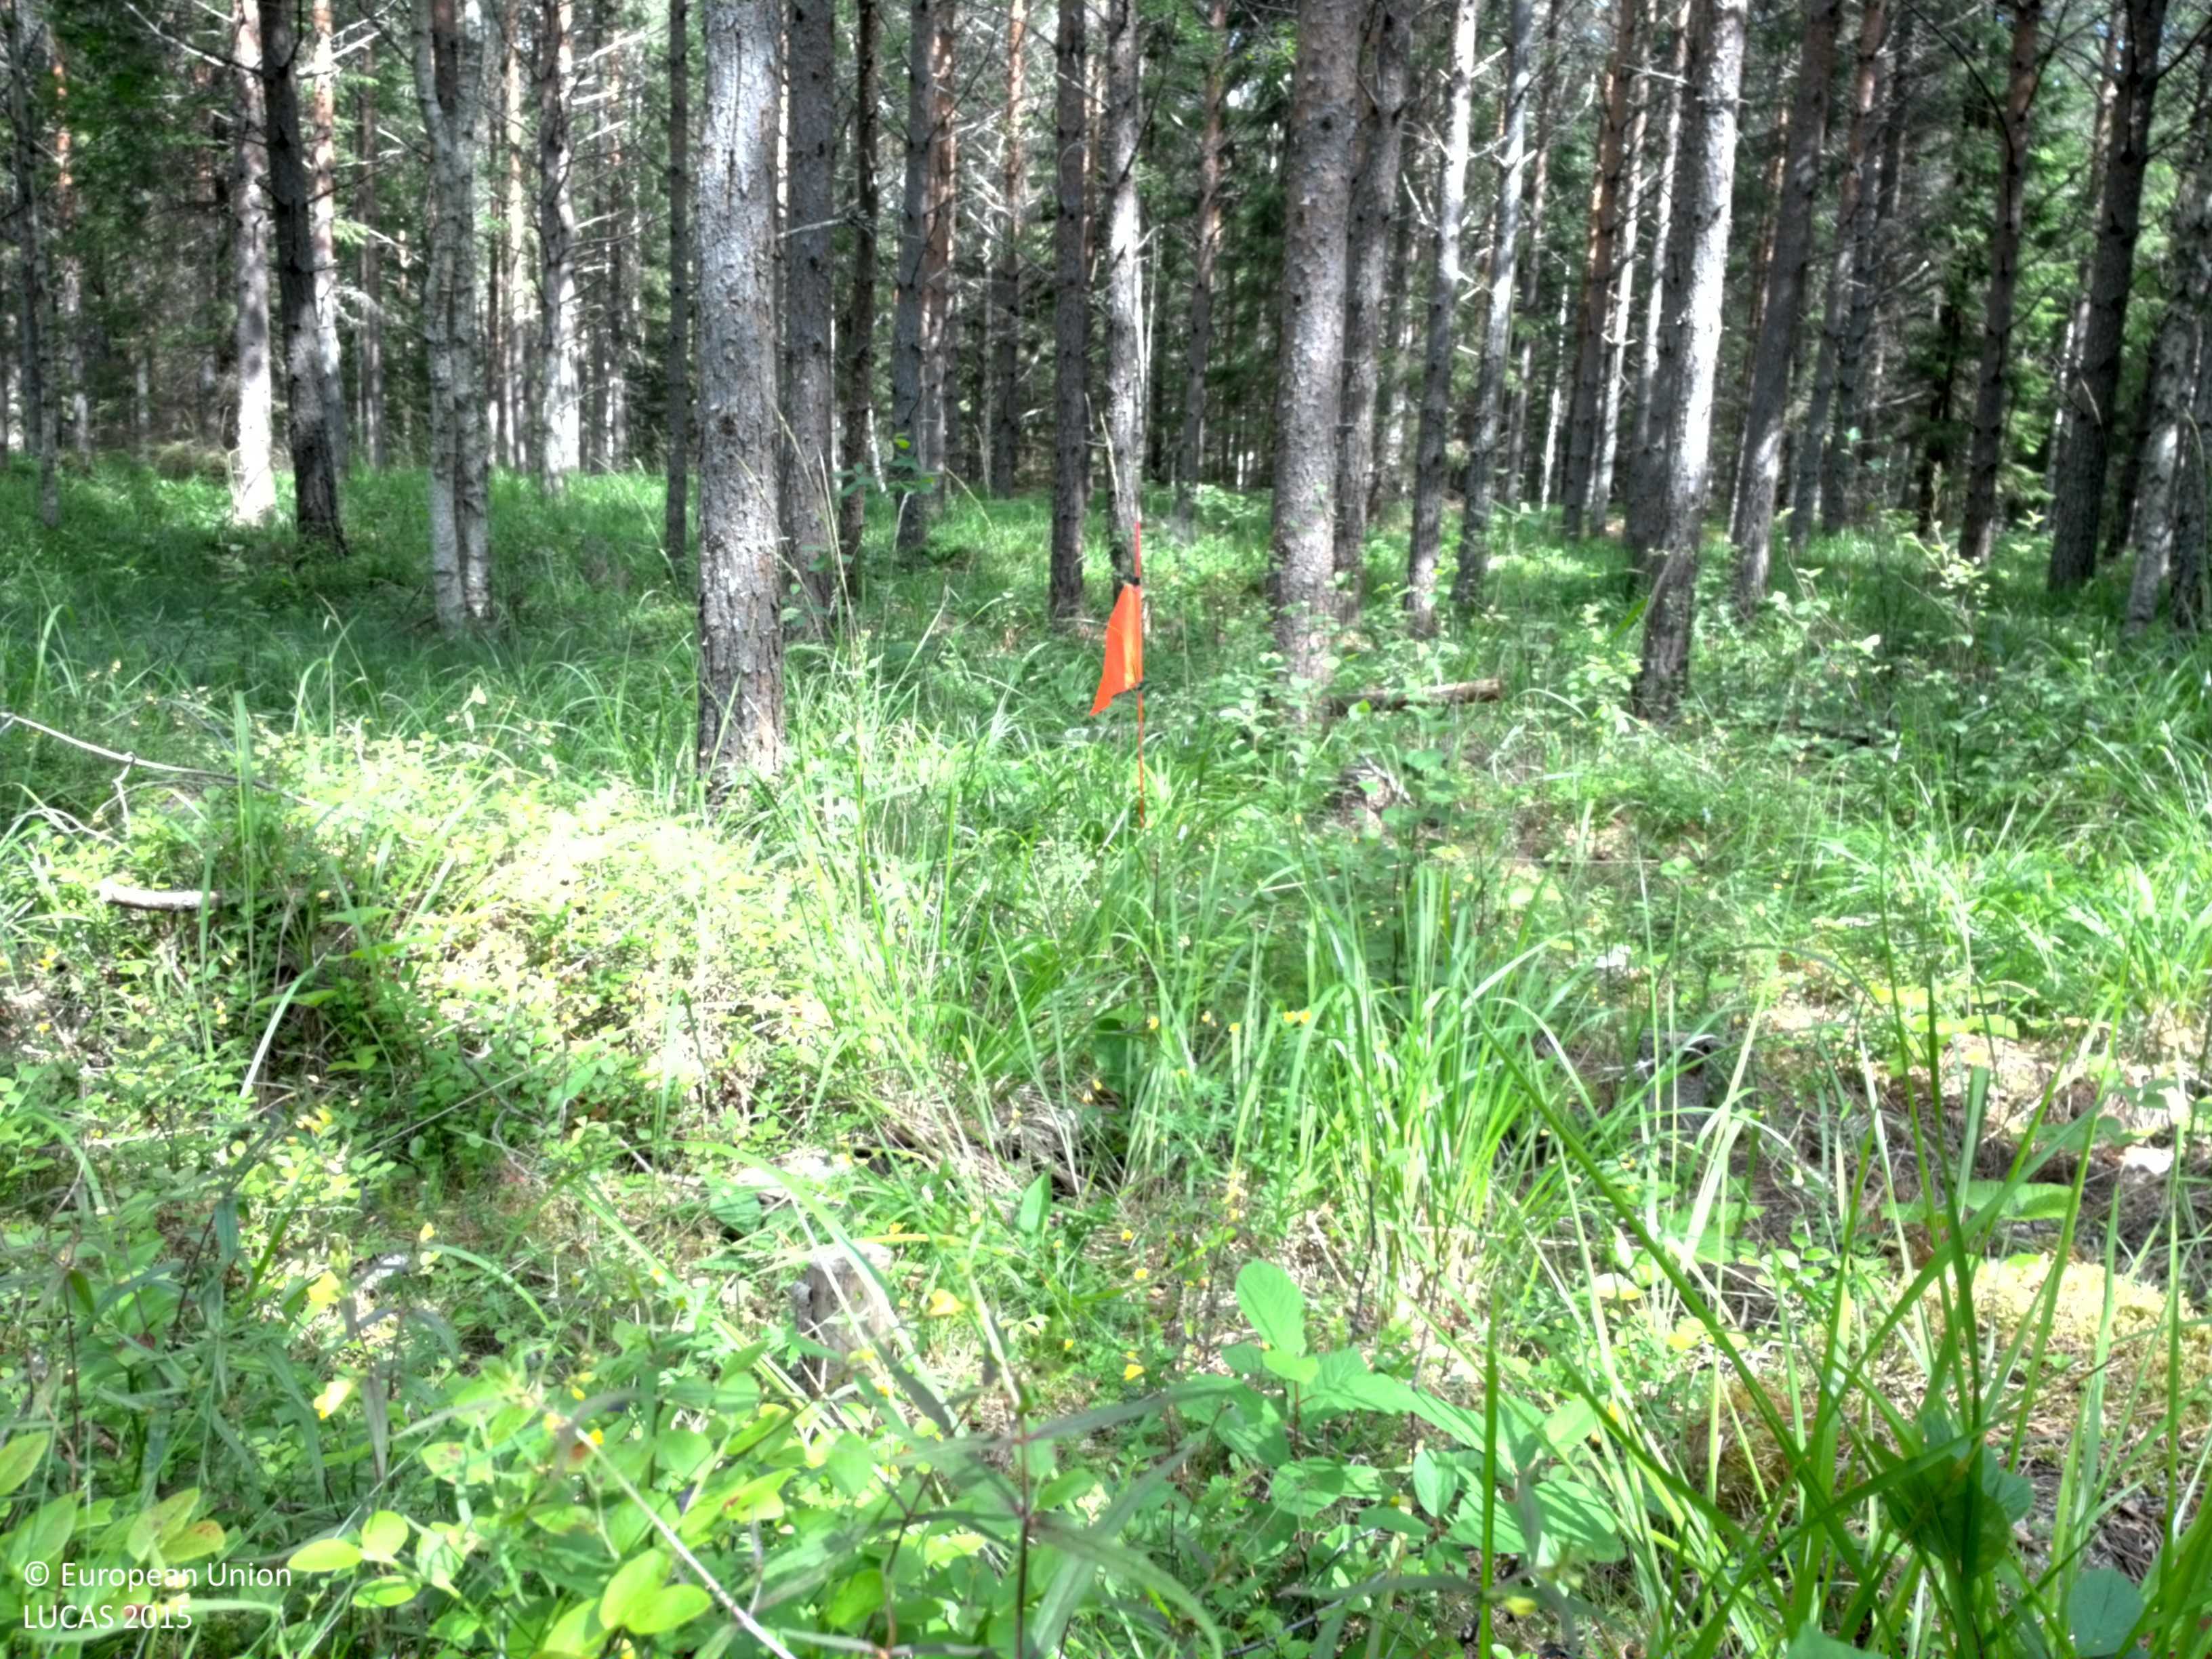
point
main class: Woodland
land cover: Pine dominated coniferous woodland
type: boreal forest
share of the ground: > 75 %
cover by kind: coniferous forest trees 70 %, shrubs 15 %, herbaceous plants 10 %, broadleaved forest trees 5 %
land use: Forestry
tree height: > 5 m
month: July
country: SE
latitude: 60.0047
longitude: 18.6600
